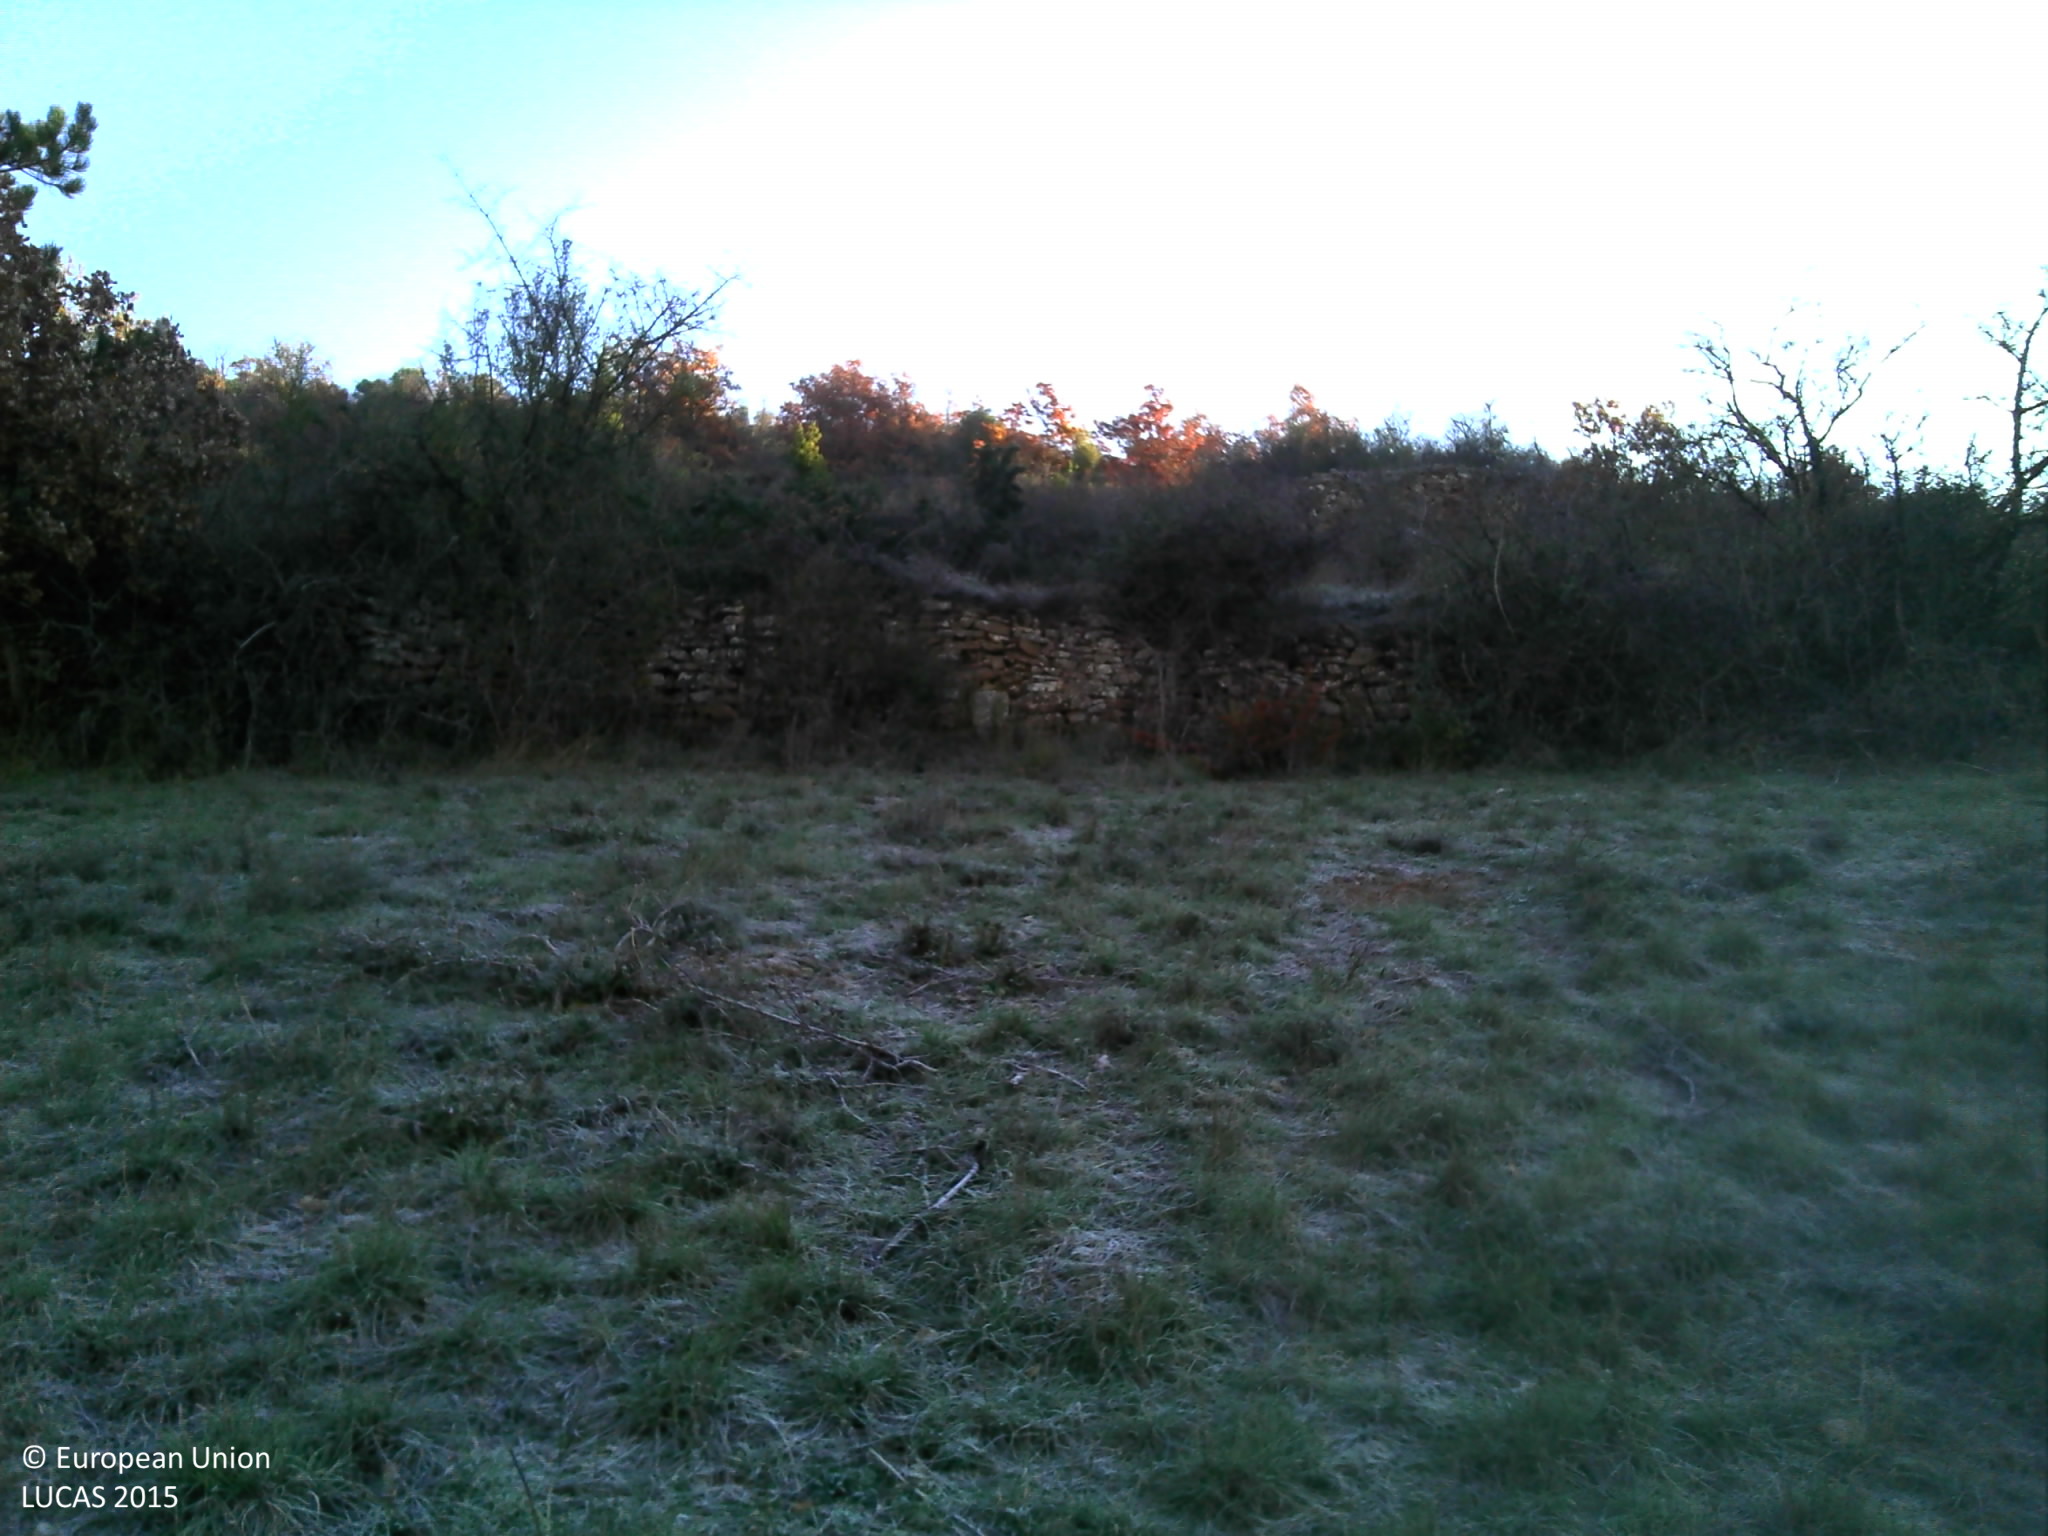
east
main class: Grassland
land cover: Grassland without tree/shrub cover
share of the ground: > 75 %
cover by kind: herbaceous plants 100 %
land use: Agriculture (excluding fallow land and kitchen gardens)
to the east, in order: Grassland without tree/shrub cover; Dry stone walls; Abandoned hedges; Grassland without tree/shrub cover; Abandoned hedges; Dry stone walls; Tracks; Dry stone walls; Abandoned hedges; Grassland without tree/shrub cover; Grassland with sparse tree/shrub cover; Grassland without tree/shrub cover; Grassland with sparse tree/shrub cover
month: November
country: FR
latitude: 44.0958
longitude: 2.9983
